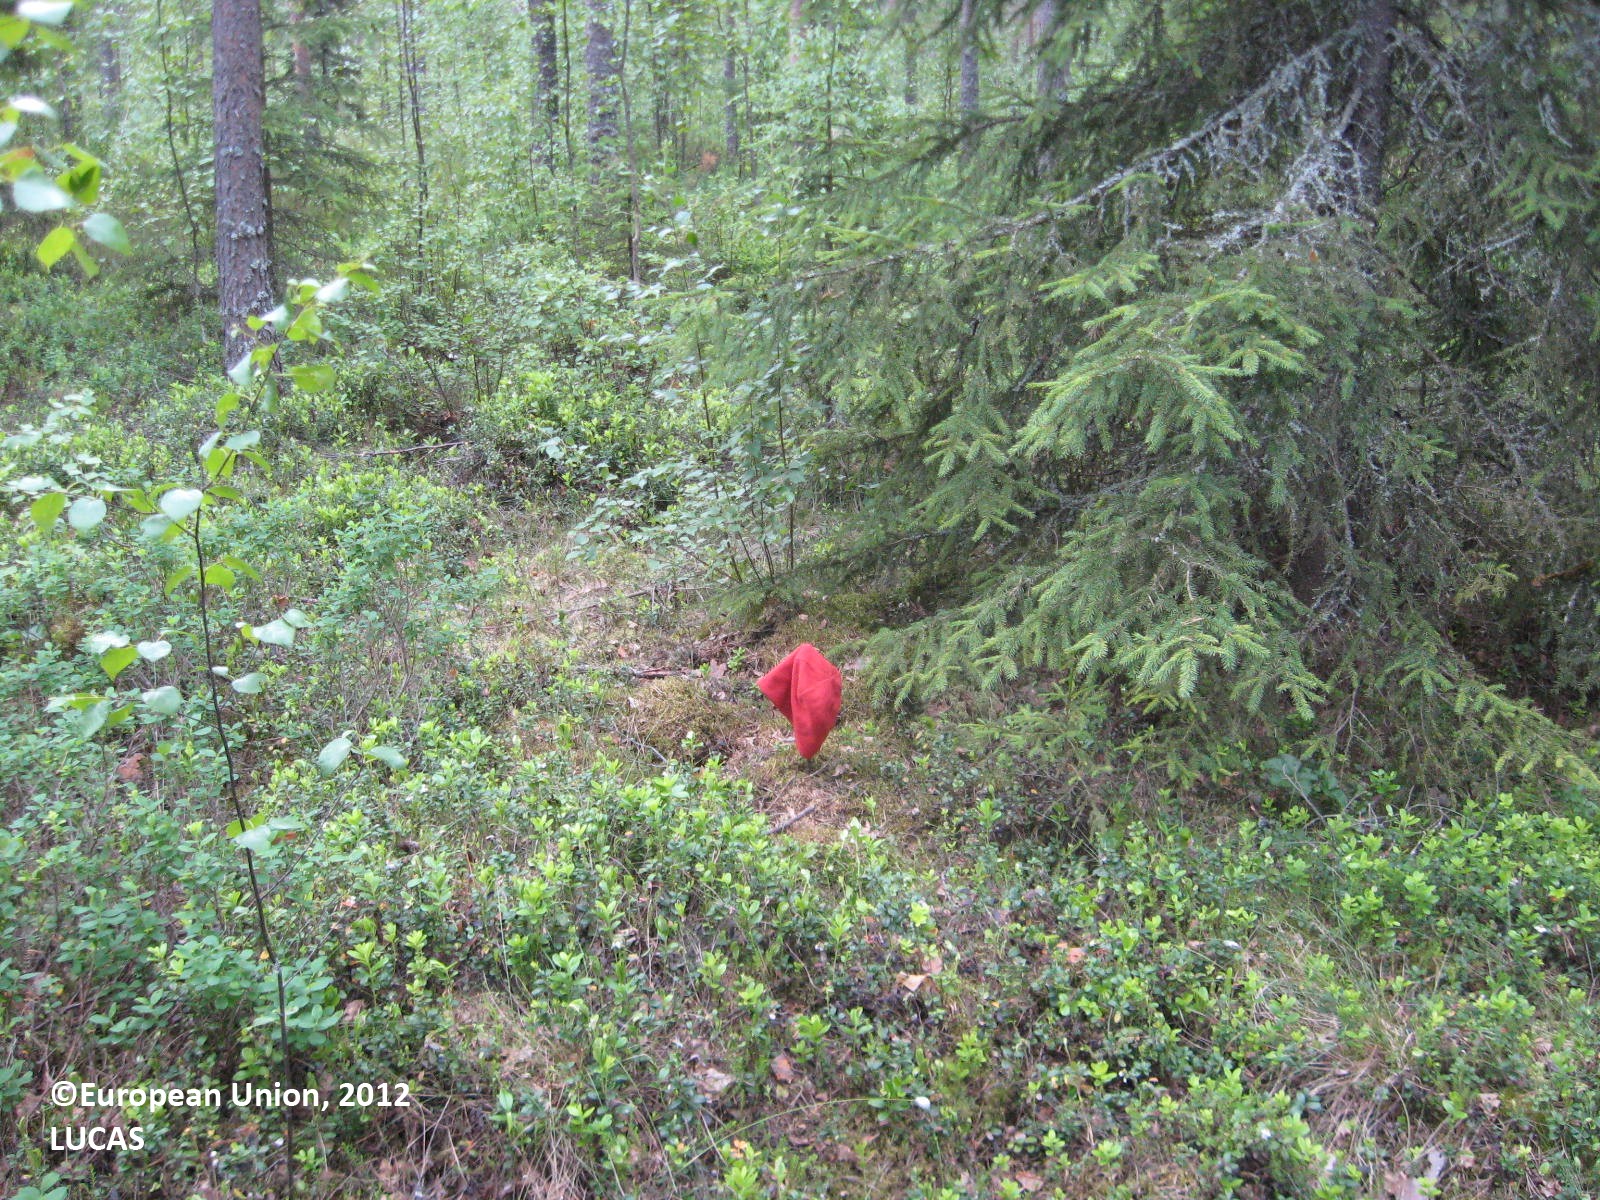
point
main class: Woodland
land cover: Other mixed woodland
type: boreal forest
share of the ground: > 75 %
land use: Forestry
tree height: > 5 m
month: July
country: FI
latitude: 62.5305
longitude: 22.4724
